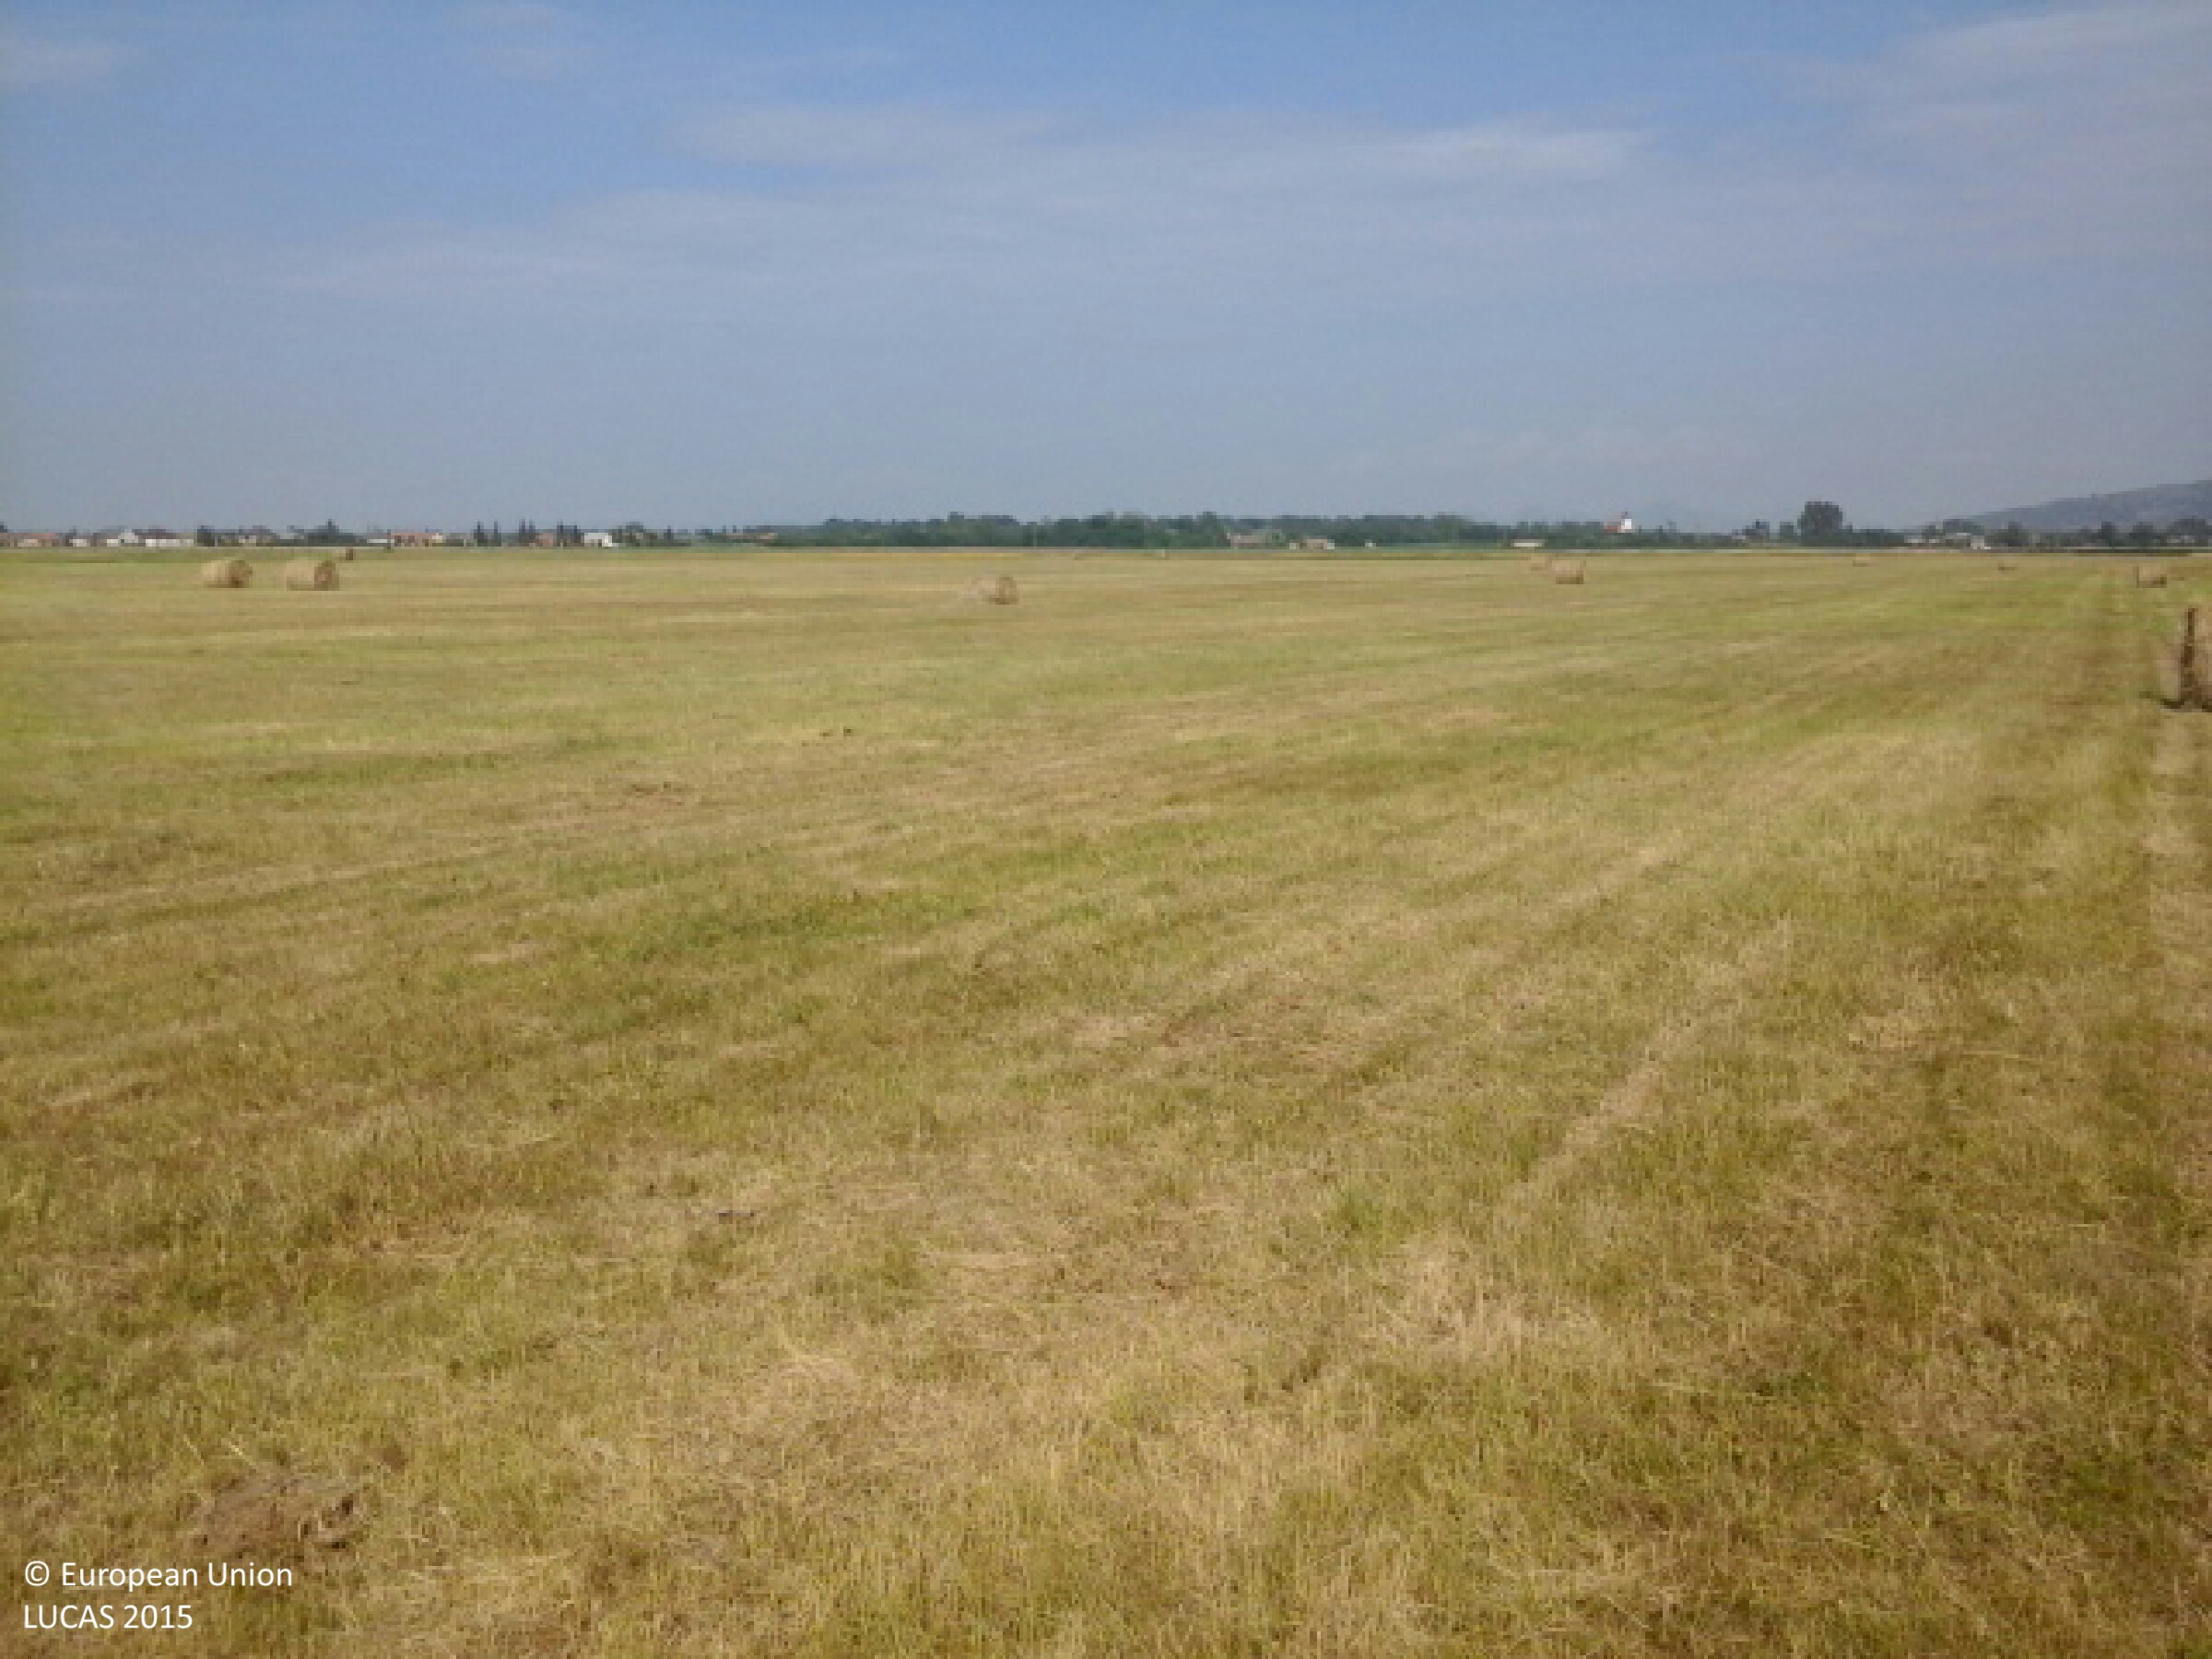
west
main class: Grassland
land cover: Grassland without tree/shrub cover
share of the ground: > 75 %
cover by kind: herbaceous plants 100 %
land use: Agriculture (excluding fallow land and kitchen gardens)
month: June
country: HU
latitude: 48.3270
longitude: 21.8532
